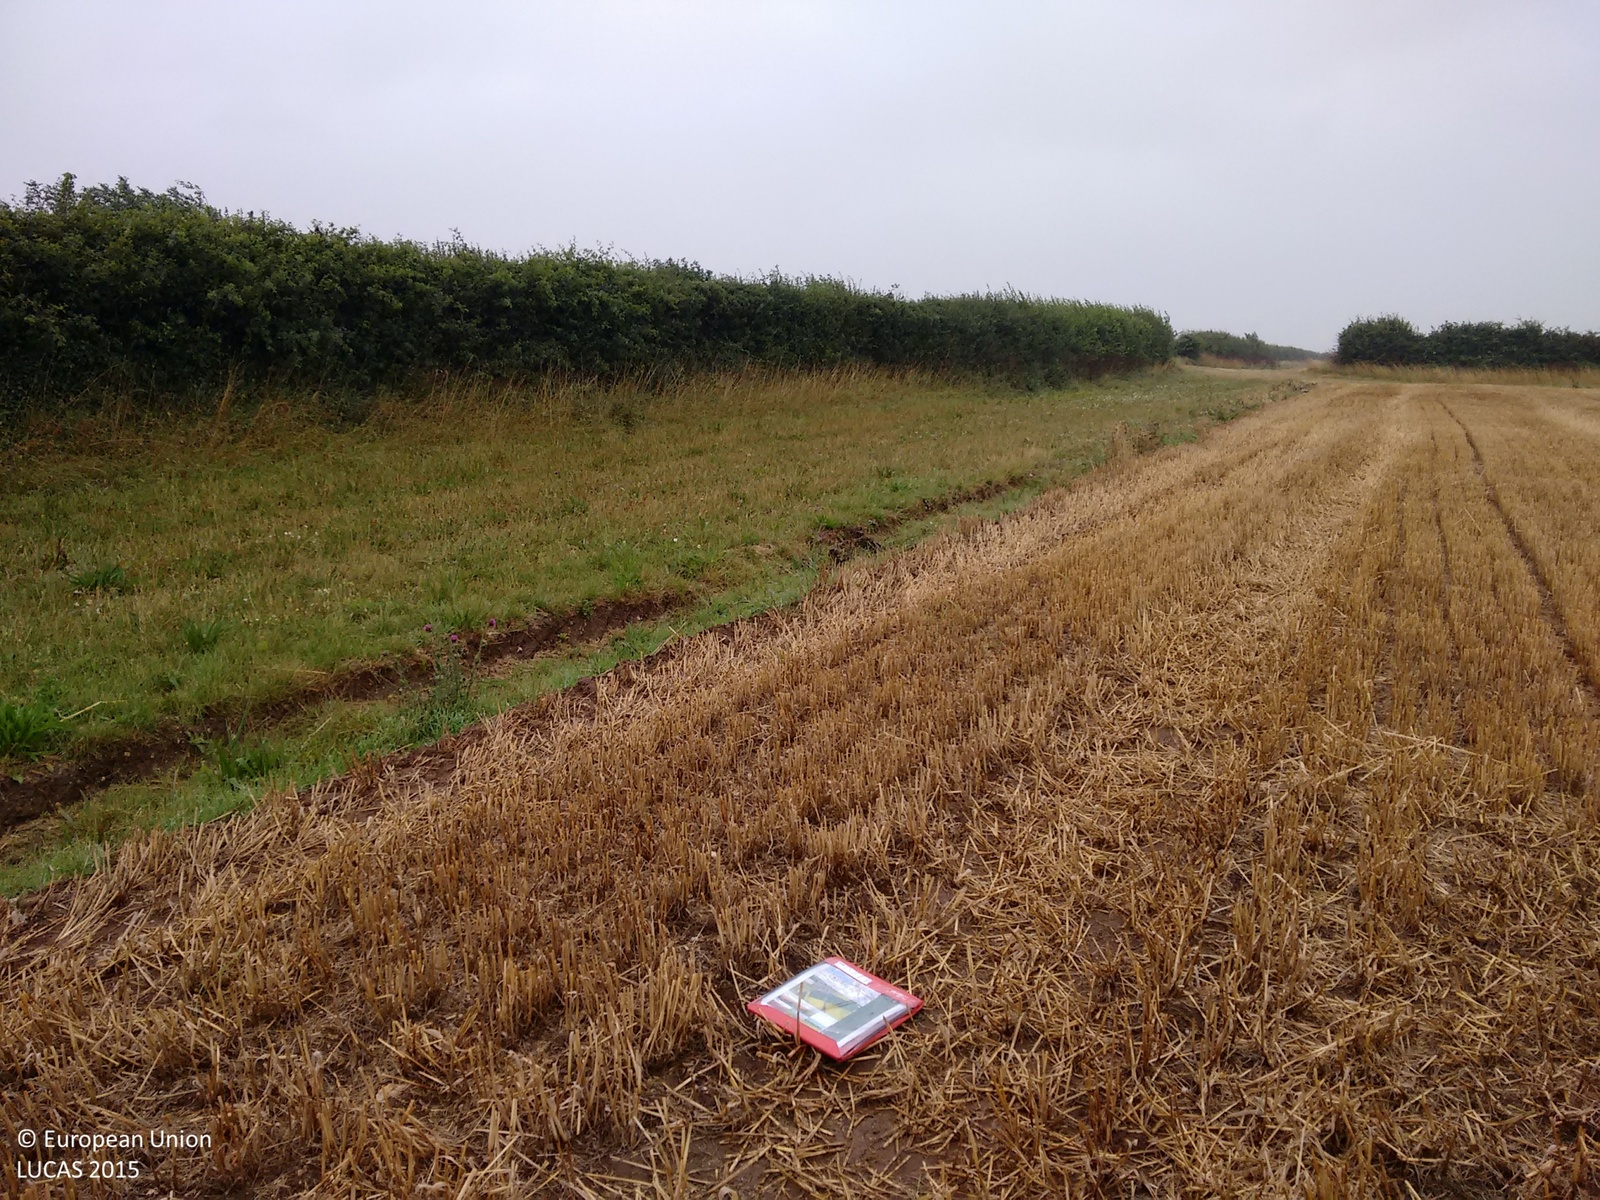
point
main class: Cropland
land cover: Common wheat
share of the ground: > 75 %
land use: Agriculture (excluding fallow land and kitchen gardens)
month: August
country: GB
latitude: 52.9375
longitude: 0.7350
